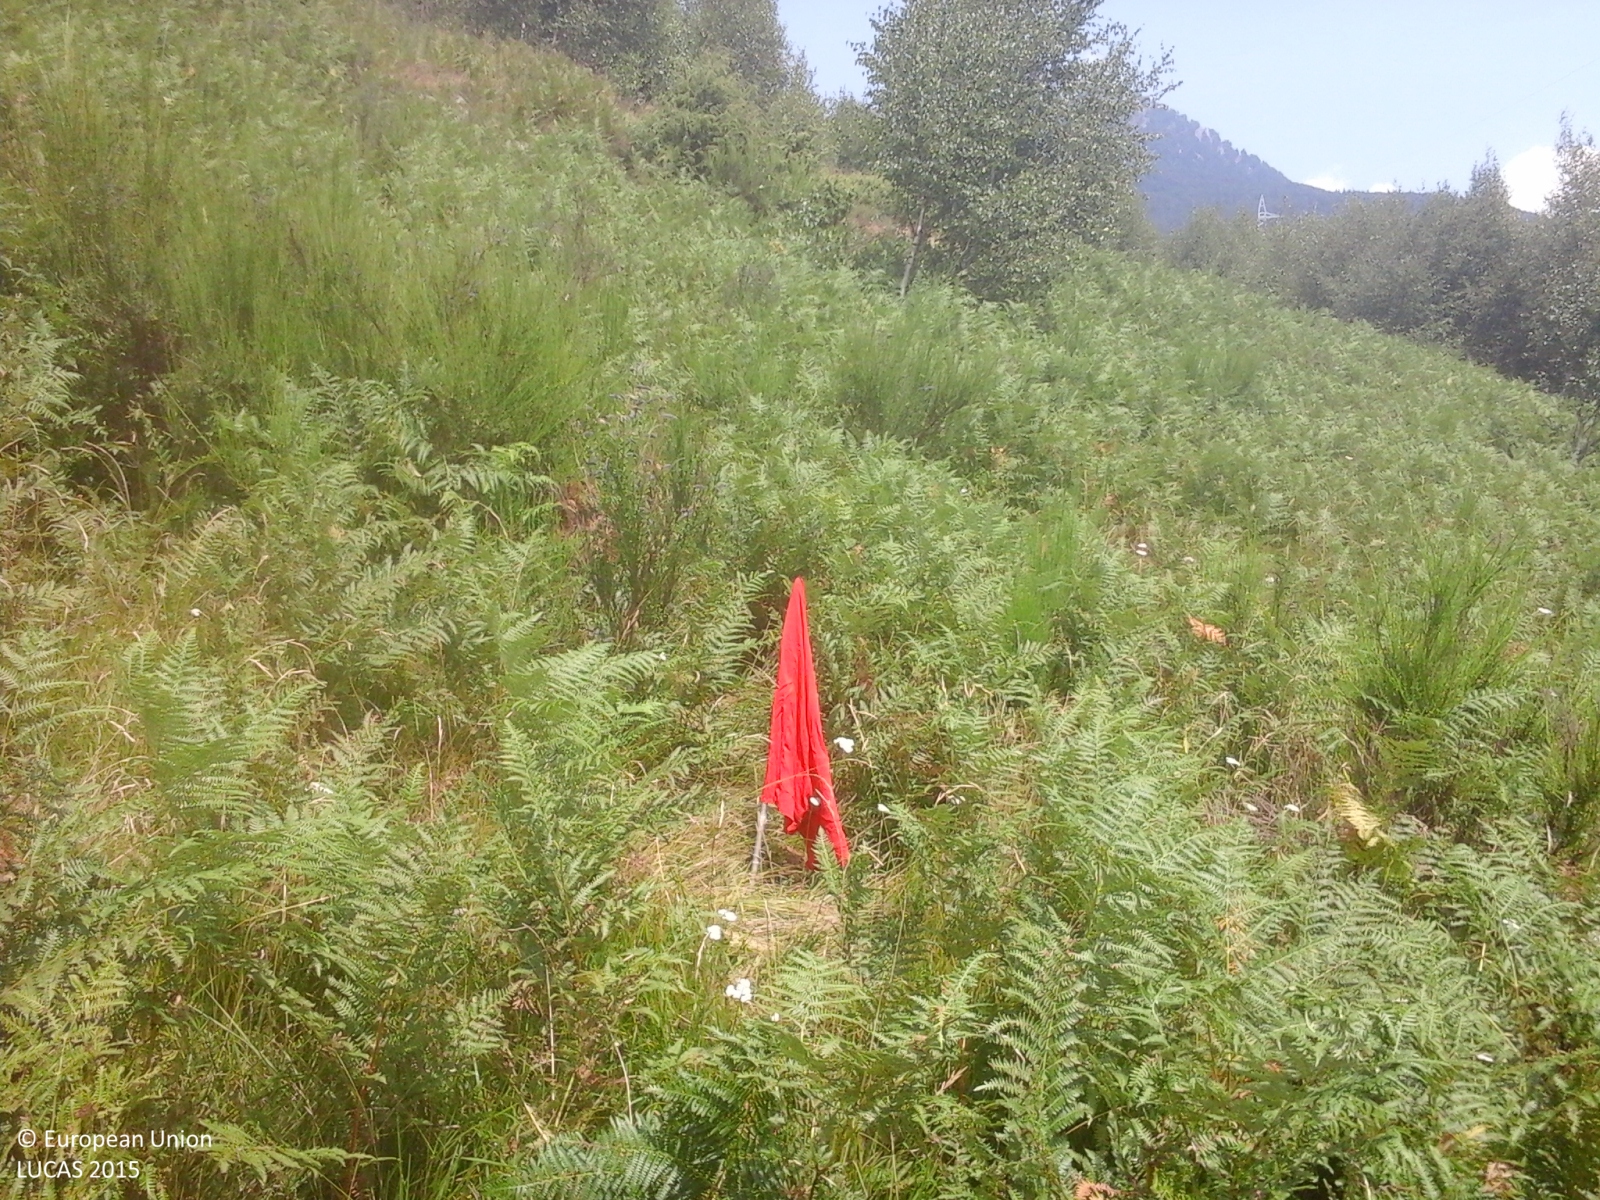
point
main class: Shrubland
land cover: Shrubland without tree cover
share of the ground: > 75 %
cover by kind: herbaceous plants 80 %, shrubs 20 %
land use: Semi-natural and natural areas not in use
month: August
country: IT
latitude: 46.1872
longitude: 9.3660
